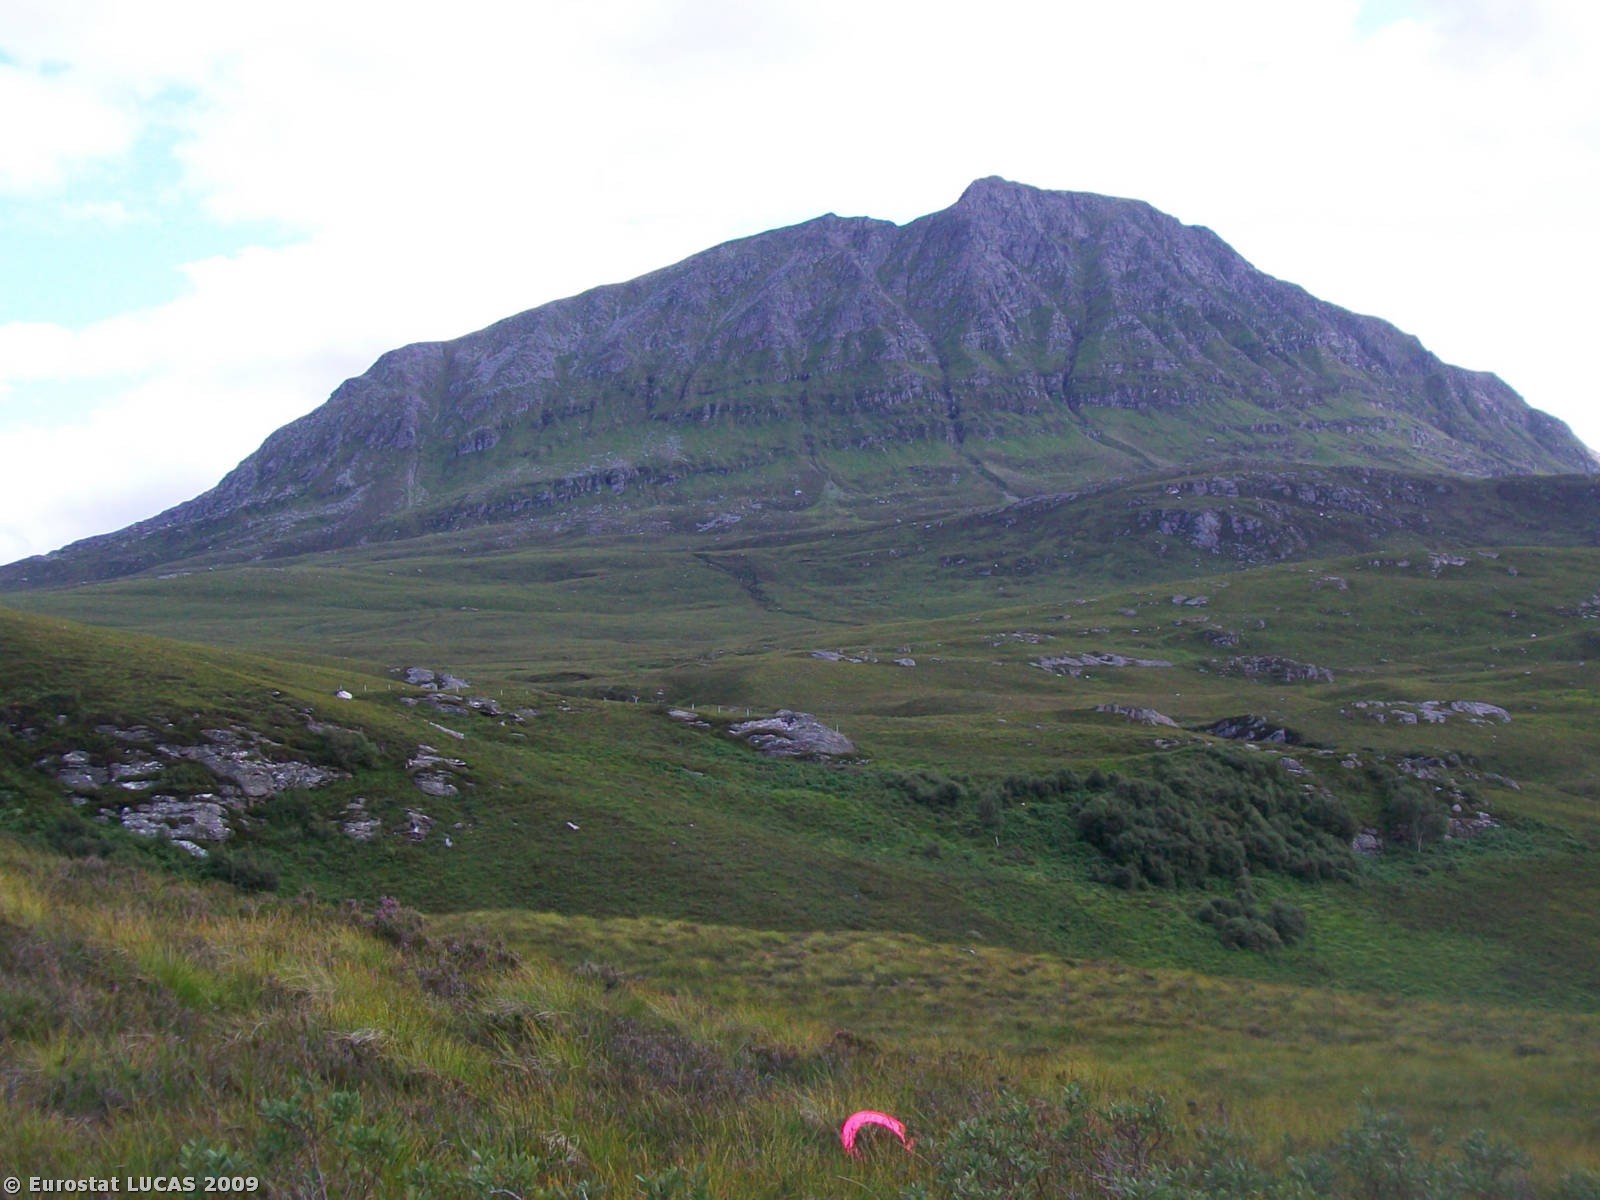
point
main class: Shrubland
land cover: Shrubland without tree cover
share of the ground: > 75 %
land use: Agriculture (excluding fallow land and kitchen gardens)
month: July
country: GB
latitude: 58.4392
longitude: -4.6314
